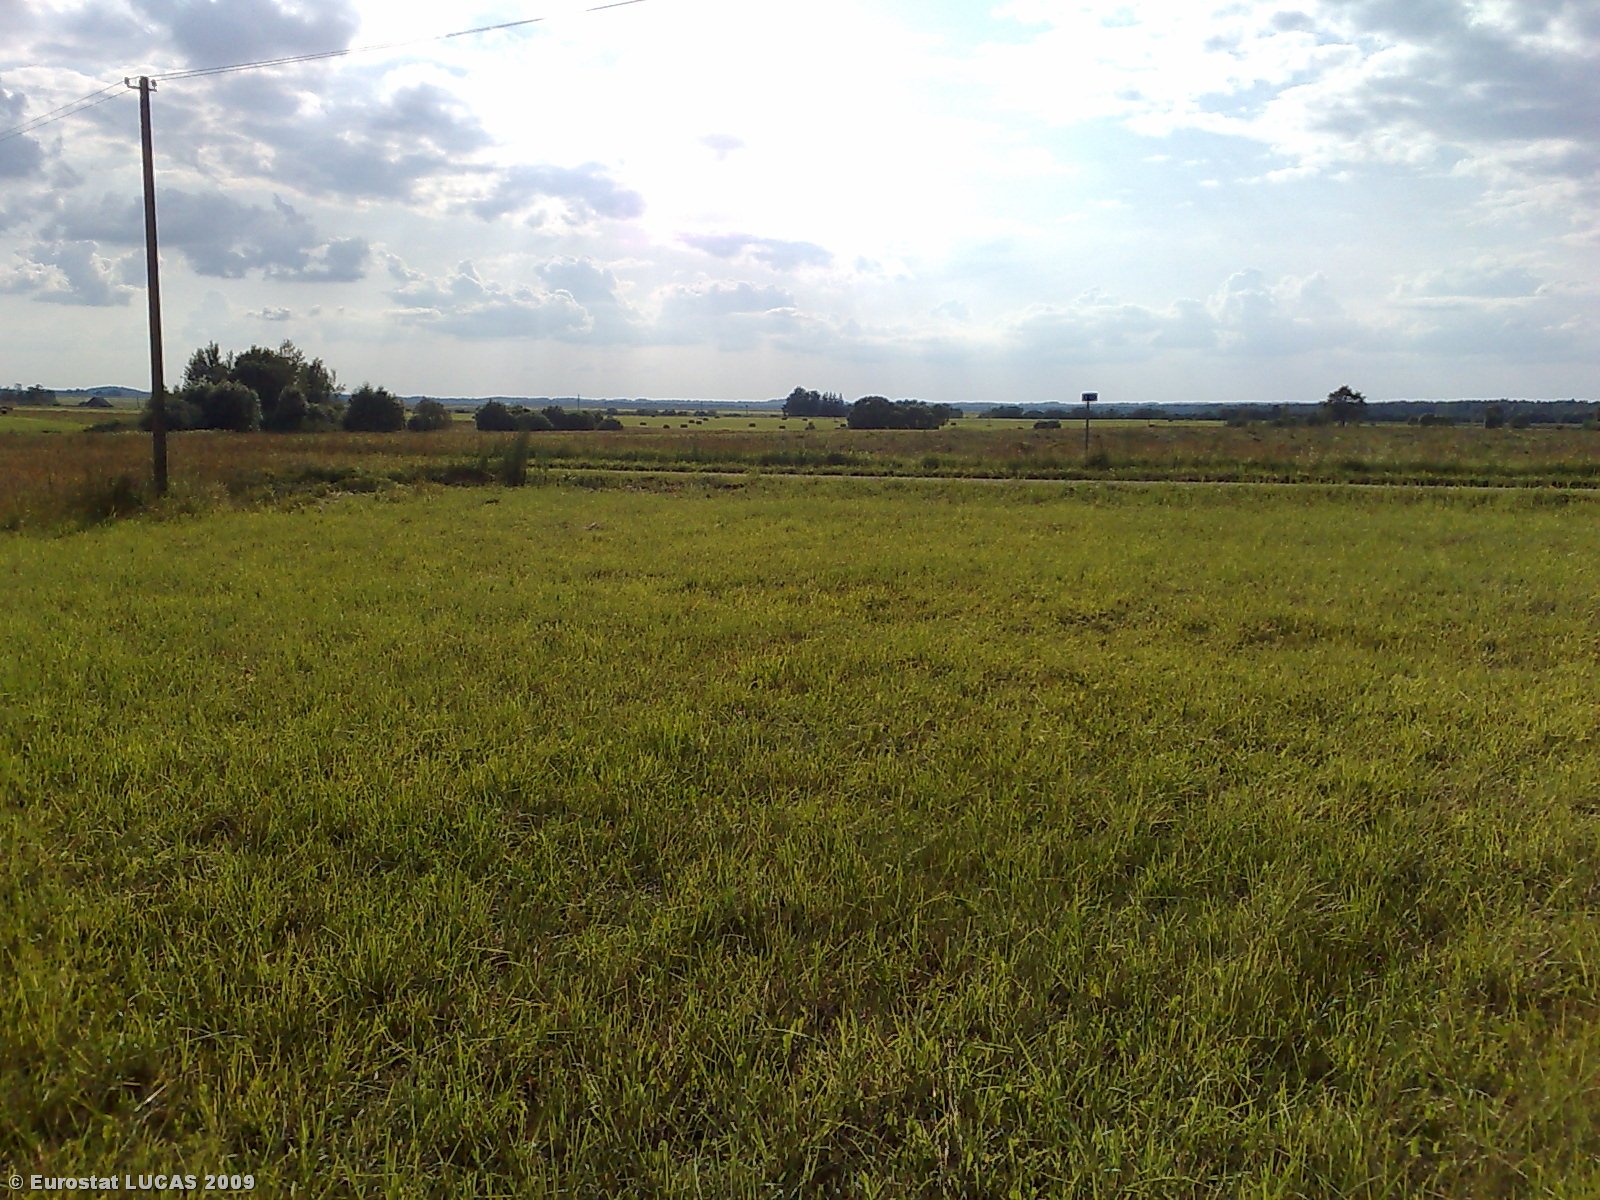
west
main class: Grassland
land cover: Grassland without tree/shrub cover
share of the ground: > 75 %
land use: Agriculture (excluding fallow land and kitchen gardens)
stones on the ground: < 10 %
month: July
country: LT
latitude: 55.7269
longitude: 22.7872
